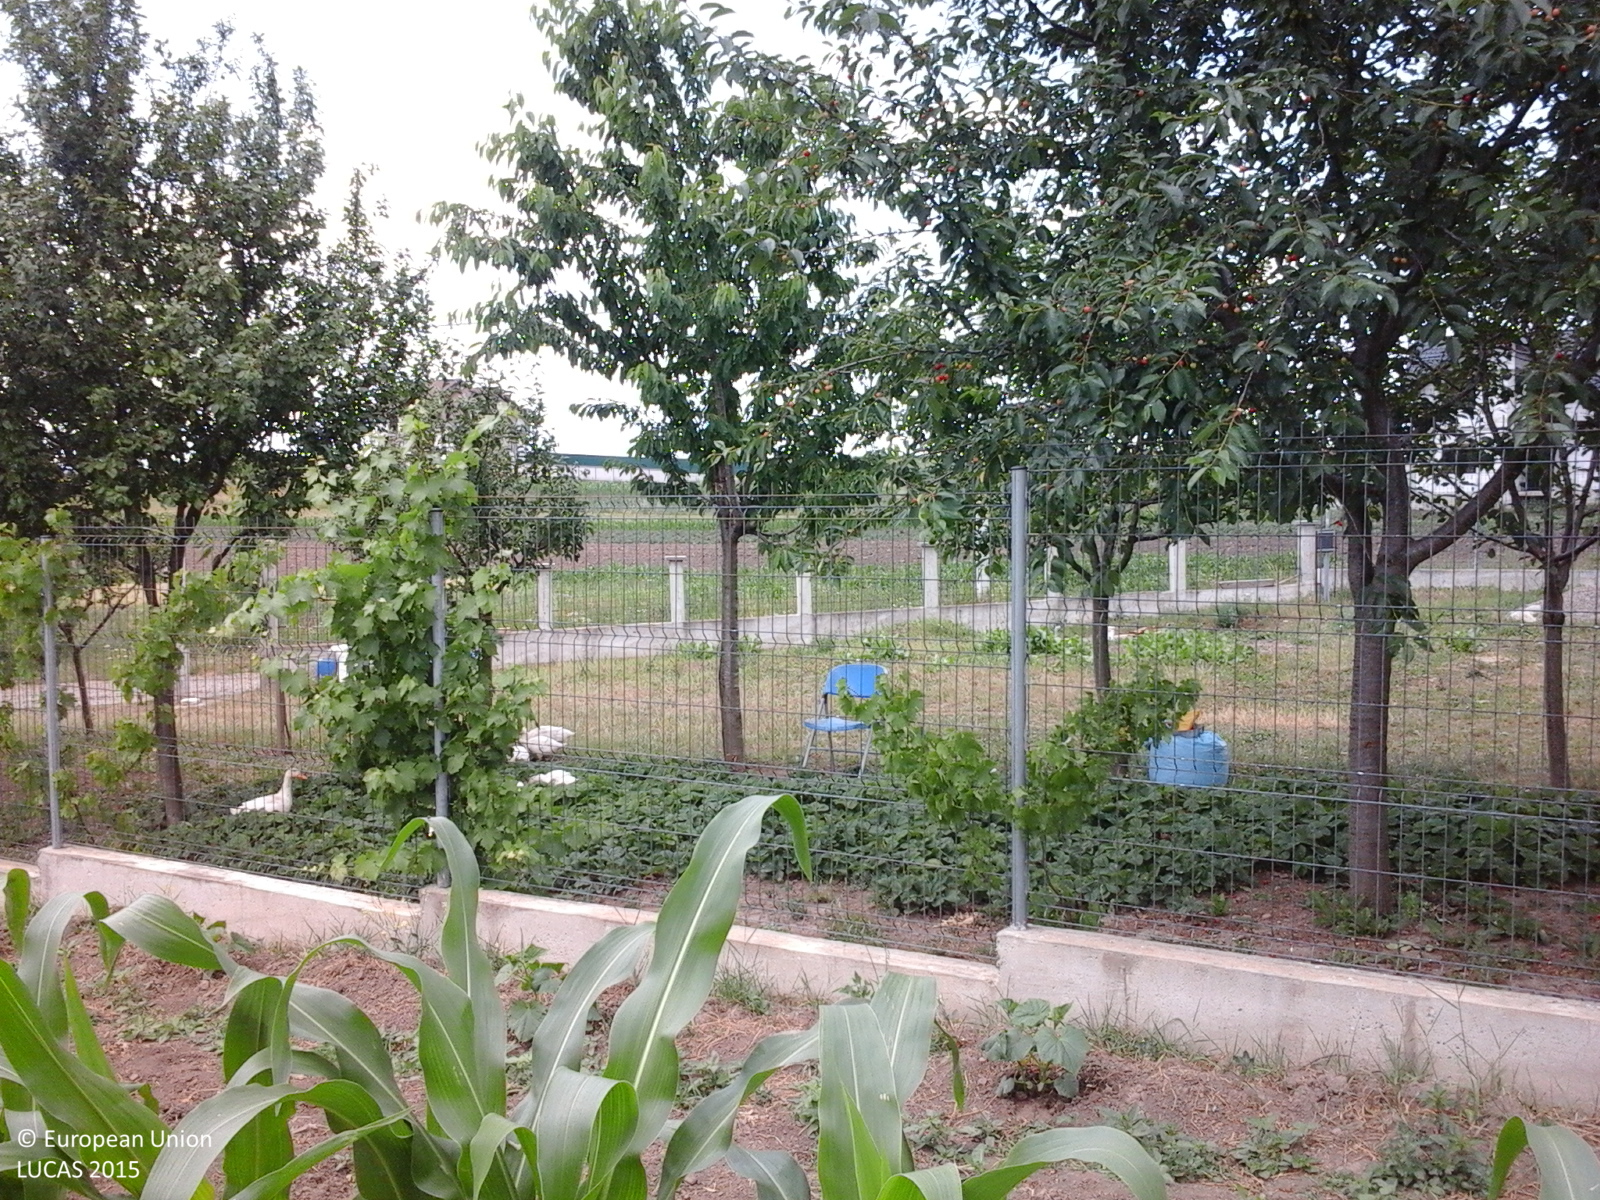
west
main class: Cropland
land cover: Maize
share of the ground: 50 - 75 %
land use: Agriculture (excluding fallow land and kitchen gardens)
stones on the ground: < 10 %
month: June
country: RO
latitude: 47.6539
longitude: 26.3420
